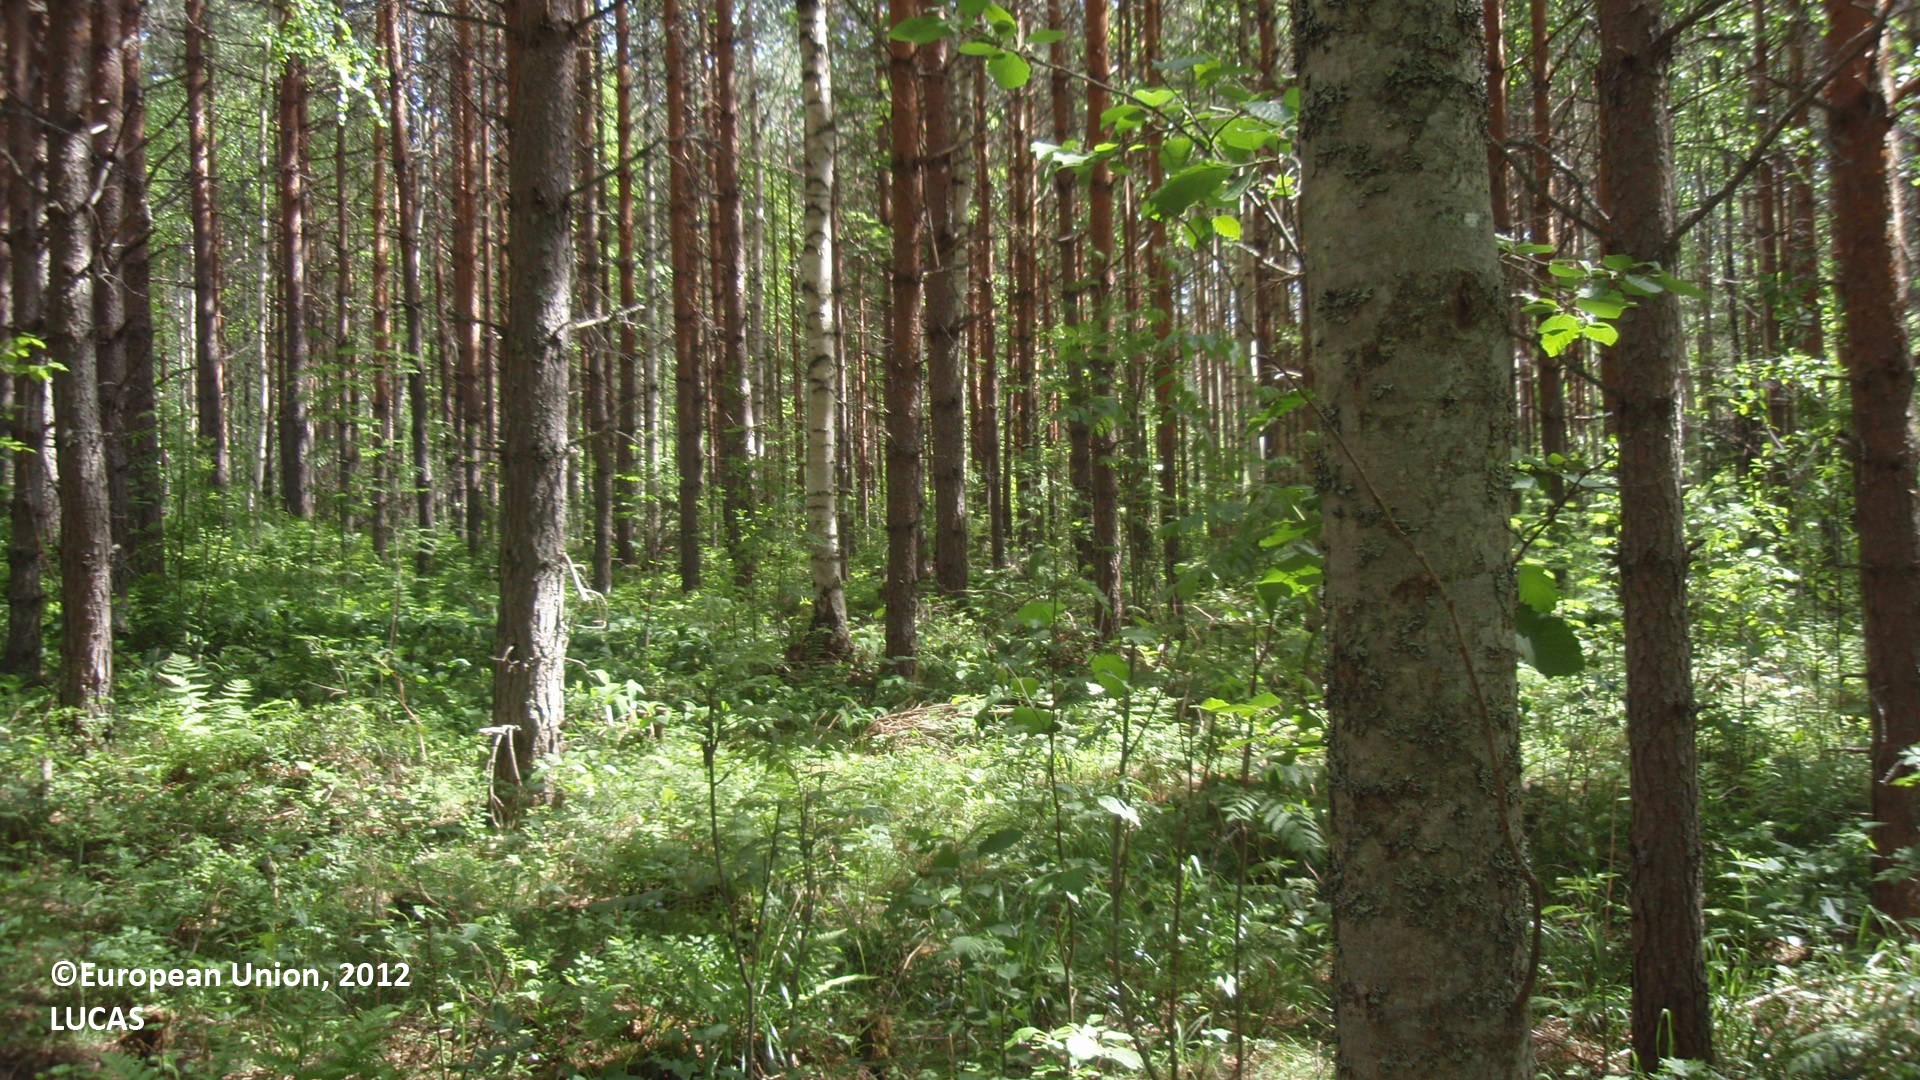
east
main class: Woodland
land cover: Pine dominated mixed woodland
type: boreal forest
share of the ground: > 75 %
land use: Forestry
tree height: > 5 m
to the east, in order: Pine dominated mixed woodland; Tracks; Broadleaved woodland; Ditches and canals; Broadleaved woodland; Grassland with sparse tree/shrub cover; Pine dominated mixed woodland; Grassland with sparse tree/shrub cover; Paved roads, cycling and walking lanes; Pine dominated mixed woodland
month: June
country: FI
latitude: 61.6277
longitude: 28.4112
